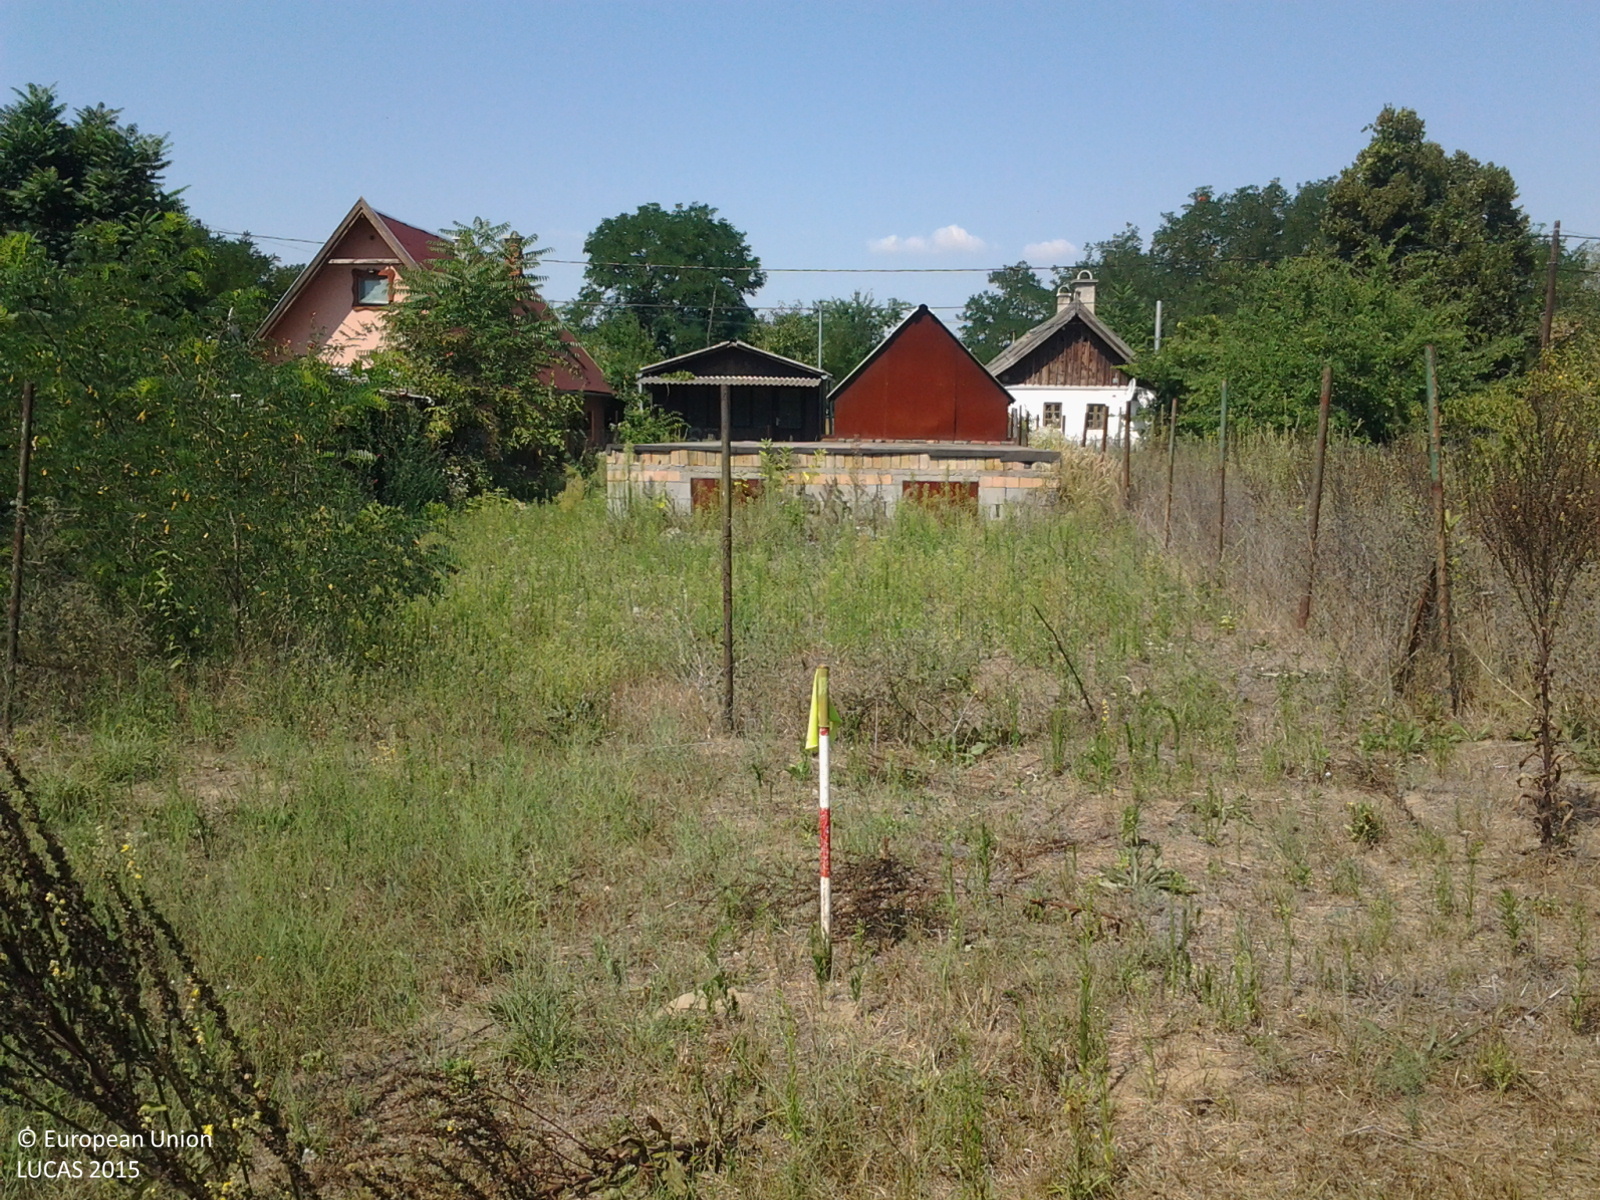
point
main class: Grassland
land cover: Spontaneously vegetated surfaces
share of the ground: > 75 %
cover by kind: herbaceous plants 100 %
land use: Fallow land
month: August
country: HU
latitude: 47.3349
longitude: 19.7766
